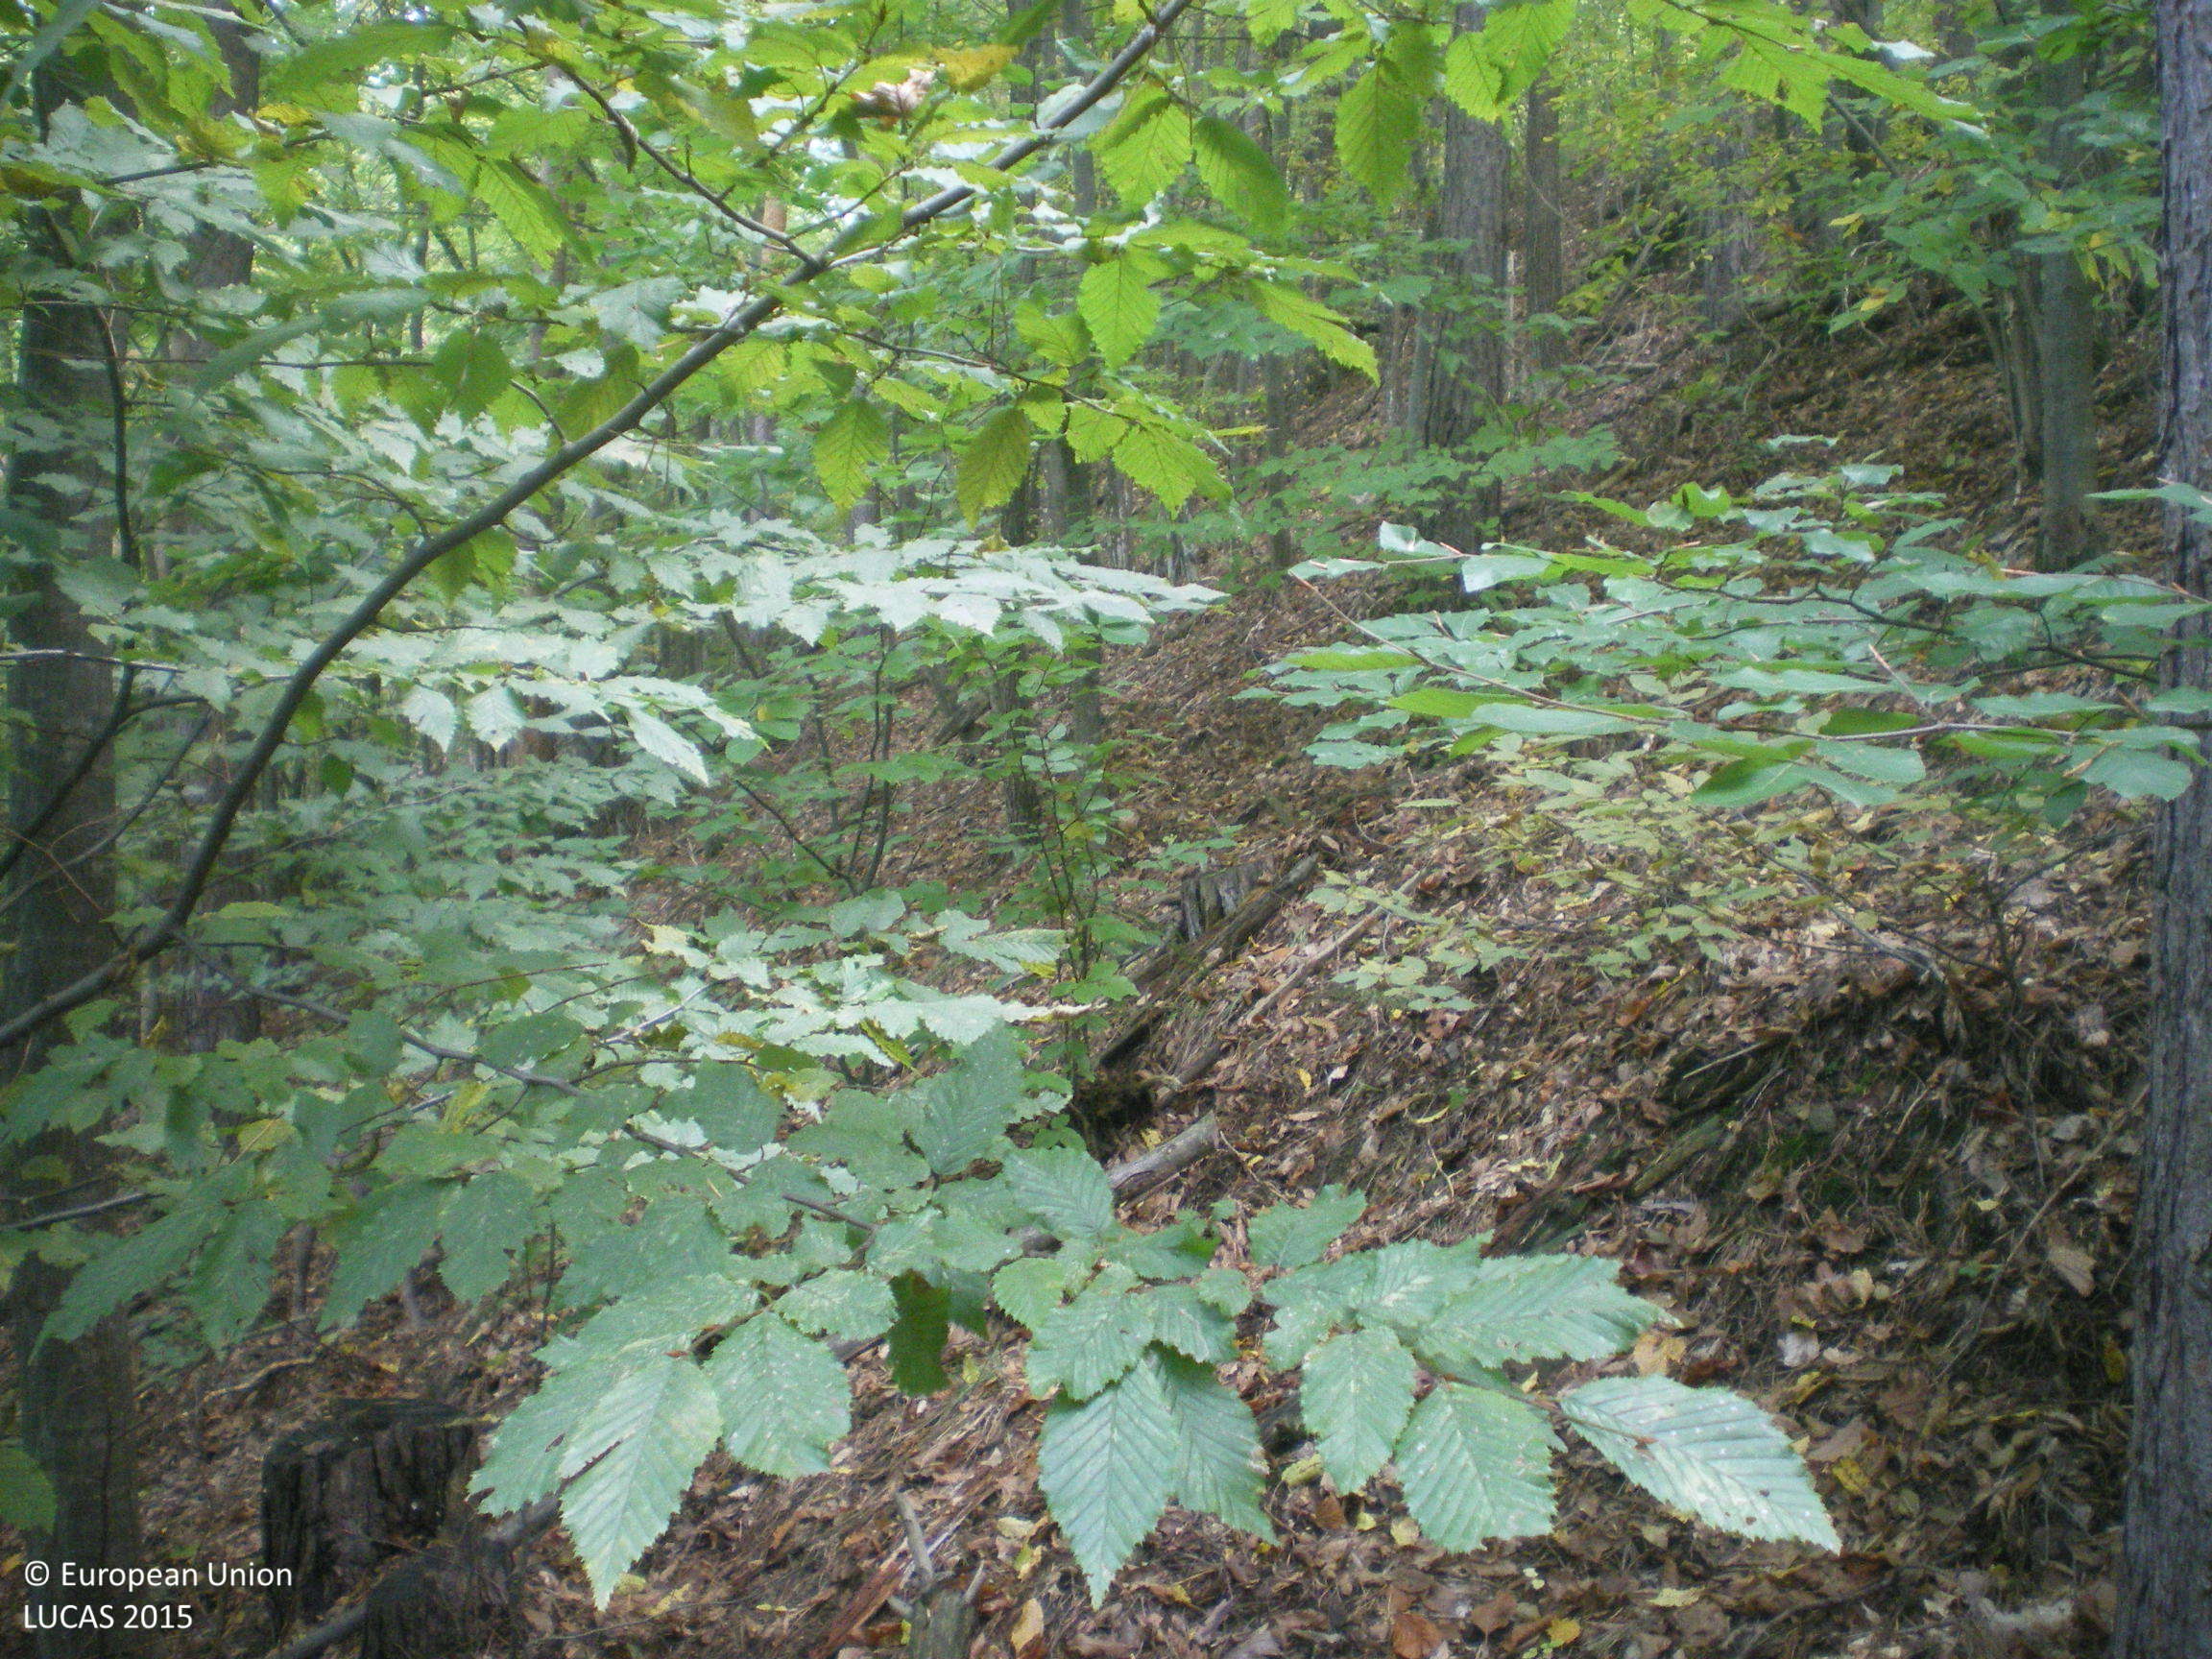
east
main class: Woodland
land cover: Pine dominated mixed woodland
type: hemiboreal forest and nemoral coniferous forest and mixed broadleaved-coniferous forest
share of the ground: > 75 %
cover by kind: coniferous forest trees 60 %, broadleaved forest trees 25 %, shrubs 15 %
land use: Forestry
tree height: > 5 m
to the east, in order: Pine dominated mixed woodland; Tracks; Pine dominated mixed woodland; Tracks; Pine dominated mixed woodland
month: October
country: BG
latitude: 42.7287
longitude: 25.6726
